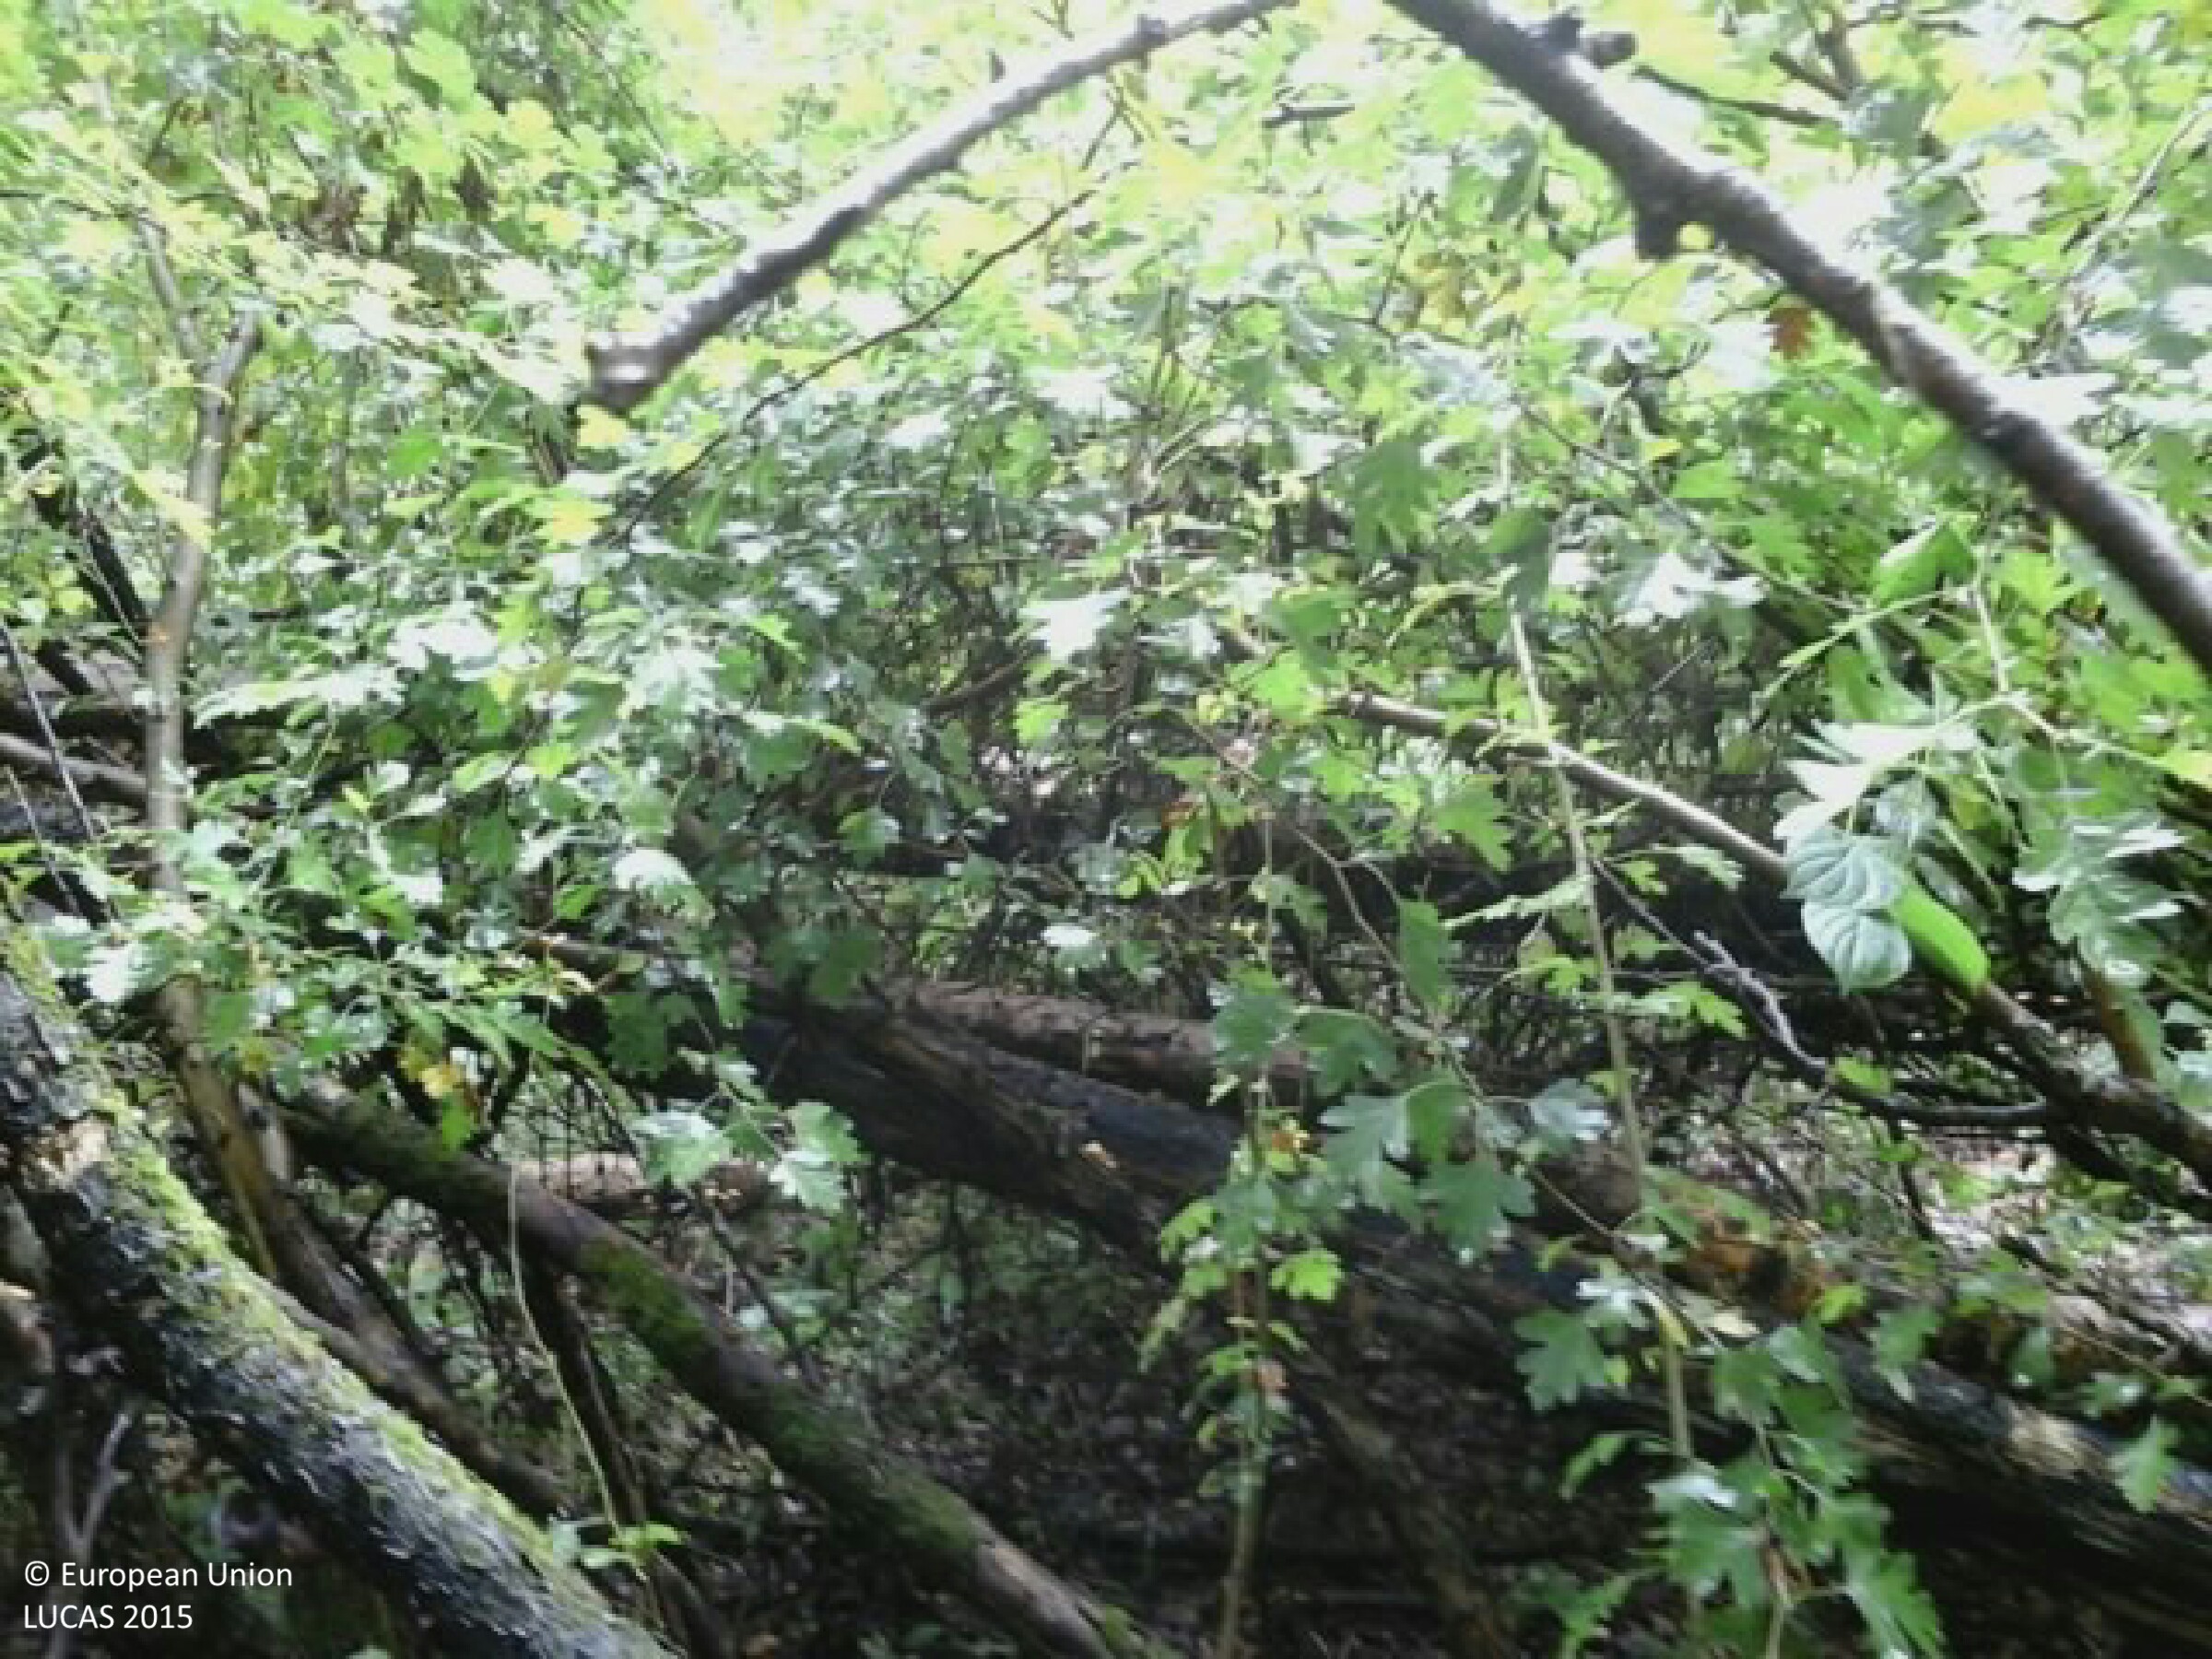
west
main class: Woodland
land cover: Broadleaved woodland
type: thermophilous deciduous forest
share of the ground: > 75 %
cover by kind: broadleaved forest trees 70 %, shrubs 20 %, coniferous forest trees 5 %, herbaceous plants 5 %
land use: Forestry
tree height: > 5 m
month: July
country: HU
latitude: 46.4188
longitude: 18.8467
